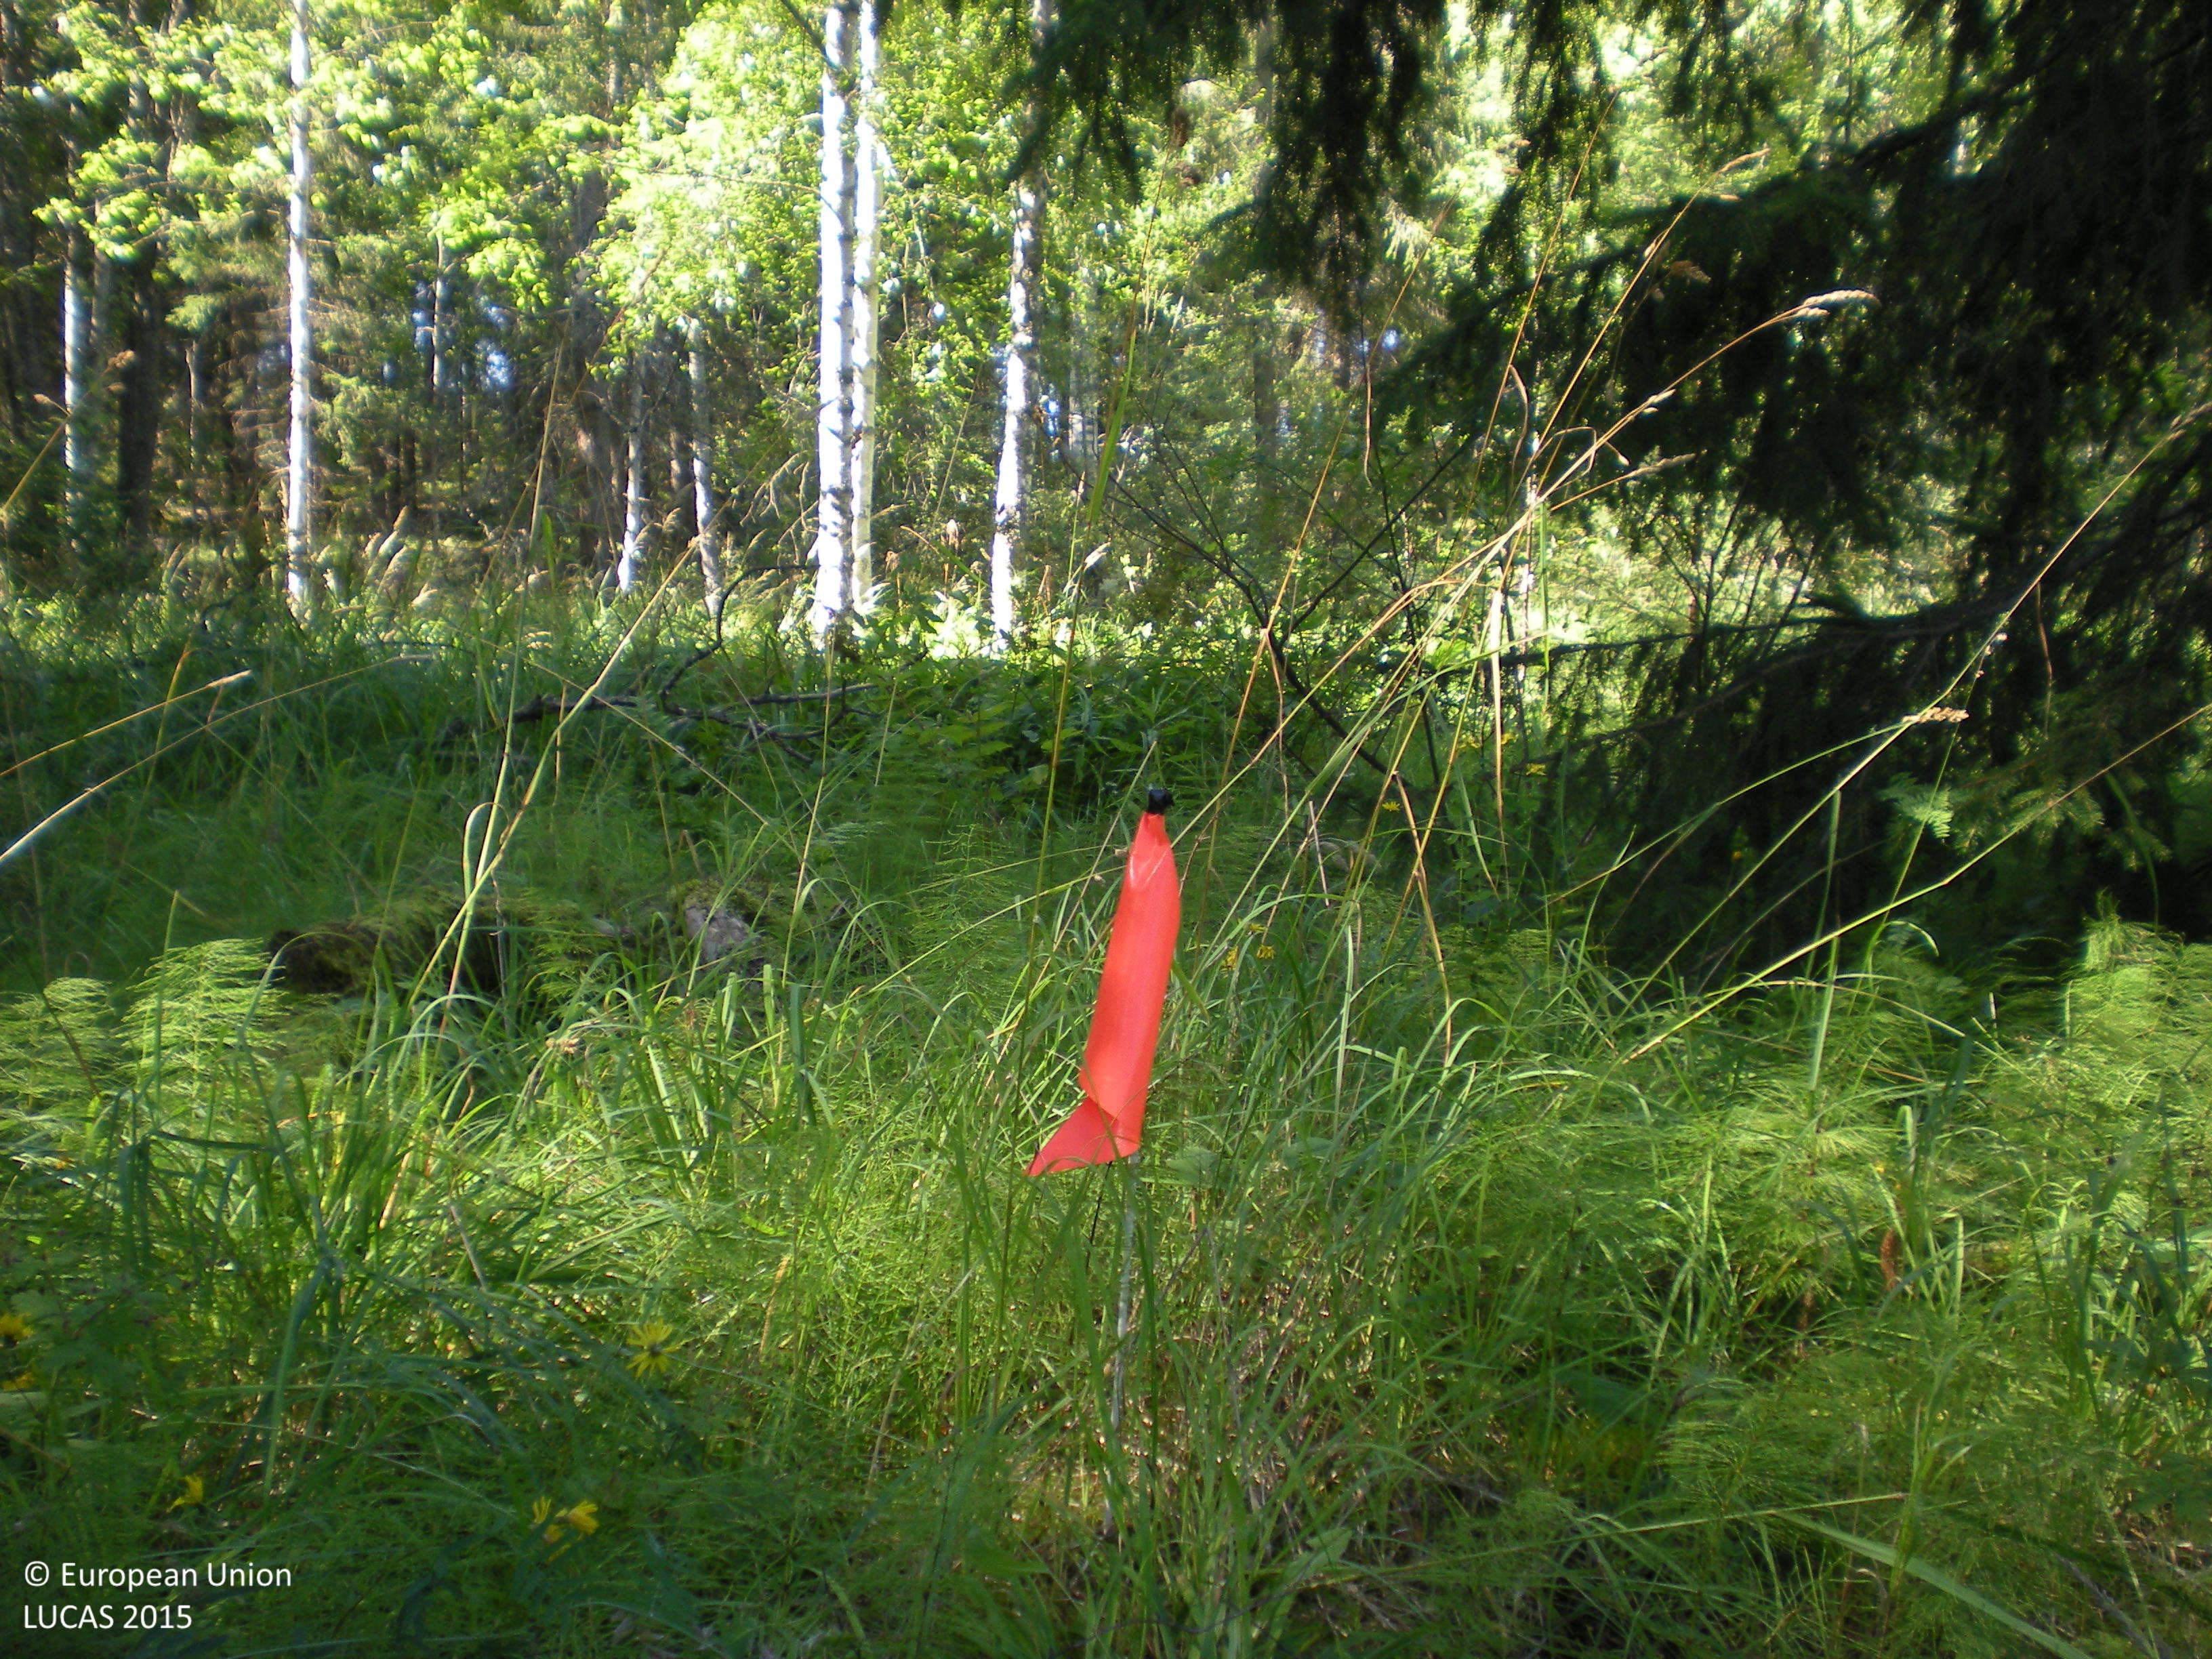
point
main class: Woodland
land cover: Spruce dominated mixed woodland
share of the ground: 50 - 75 %
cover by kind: broadleaved forest trees 35 %, herbaceous plants 30 %, coniferous forest trees 25 %, shrubs 10 %
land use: Forestry
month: August
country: SE
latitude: 60.6293
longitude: 16.8429
